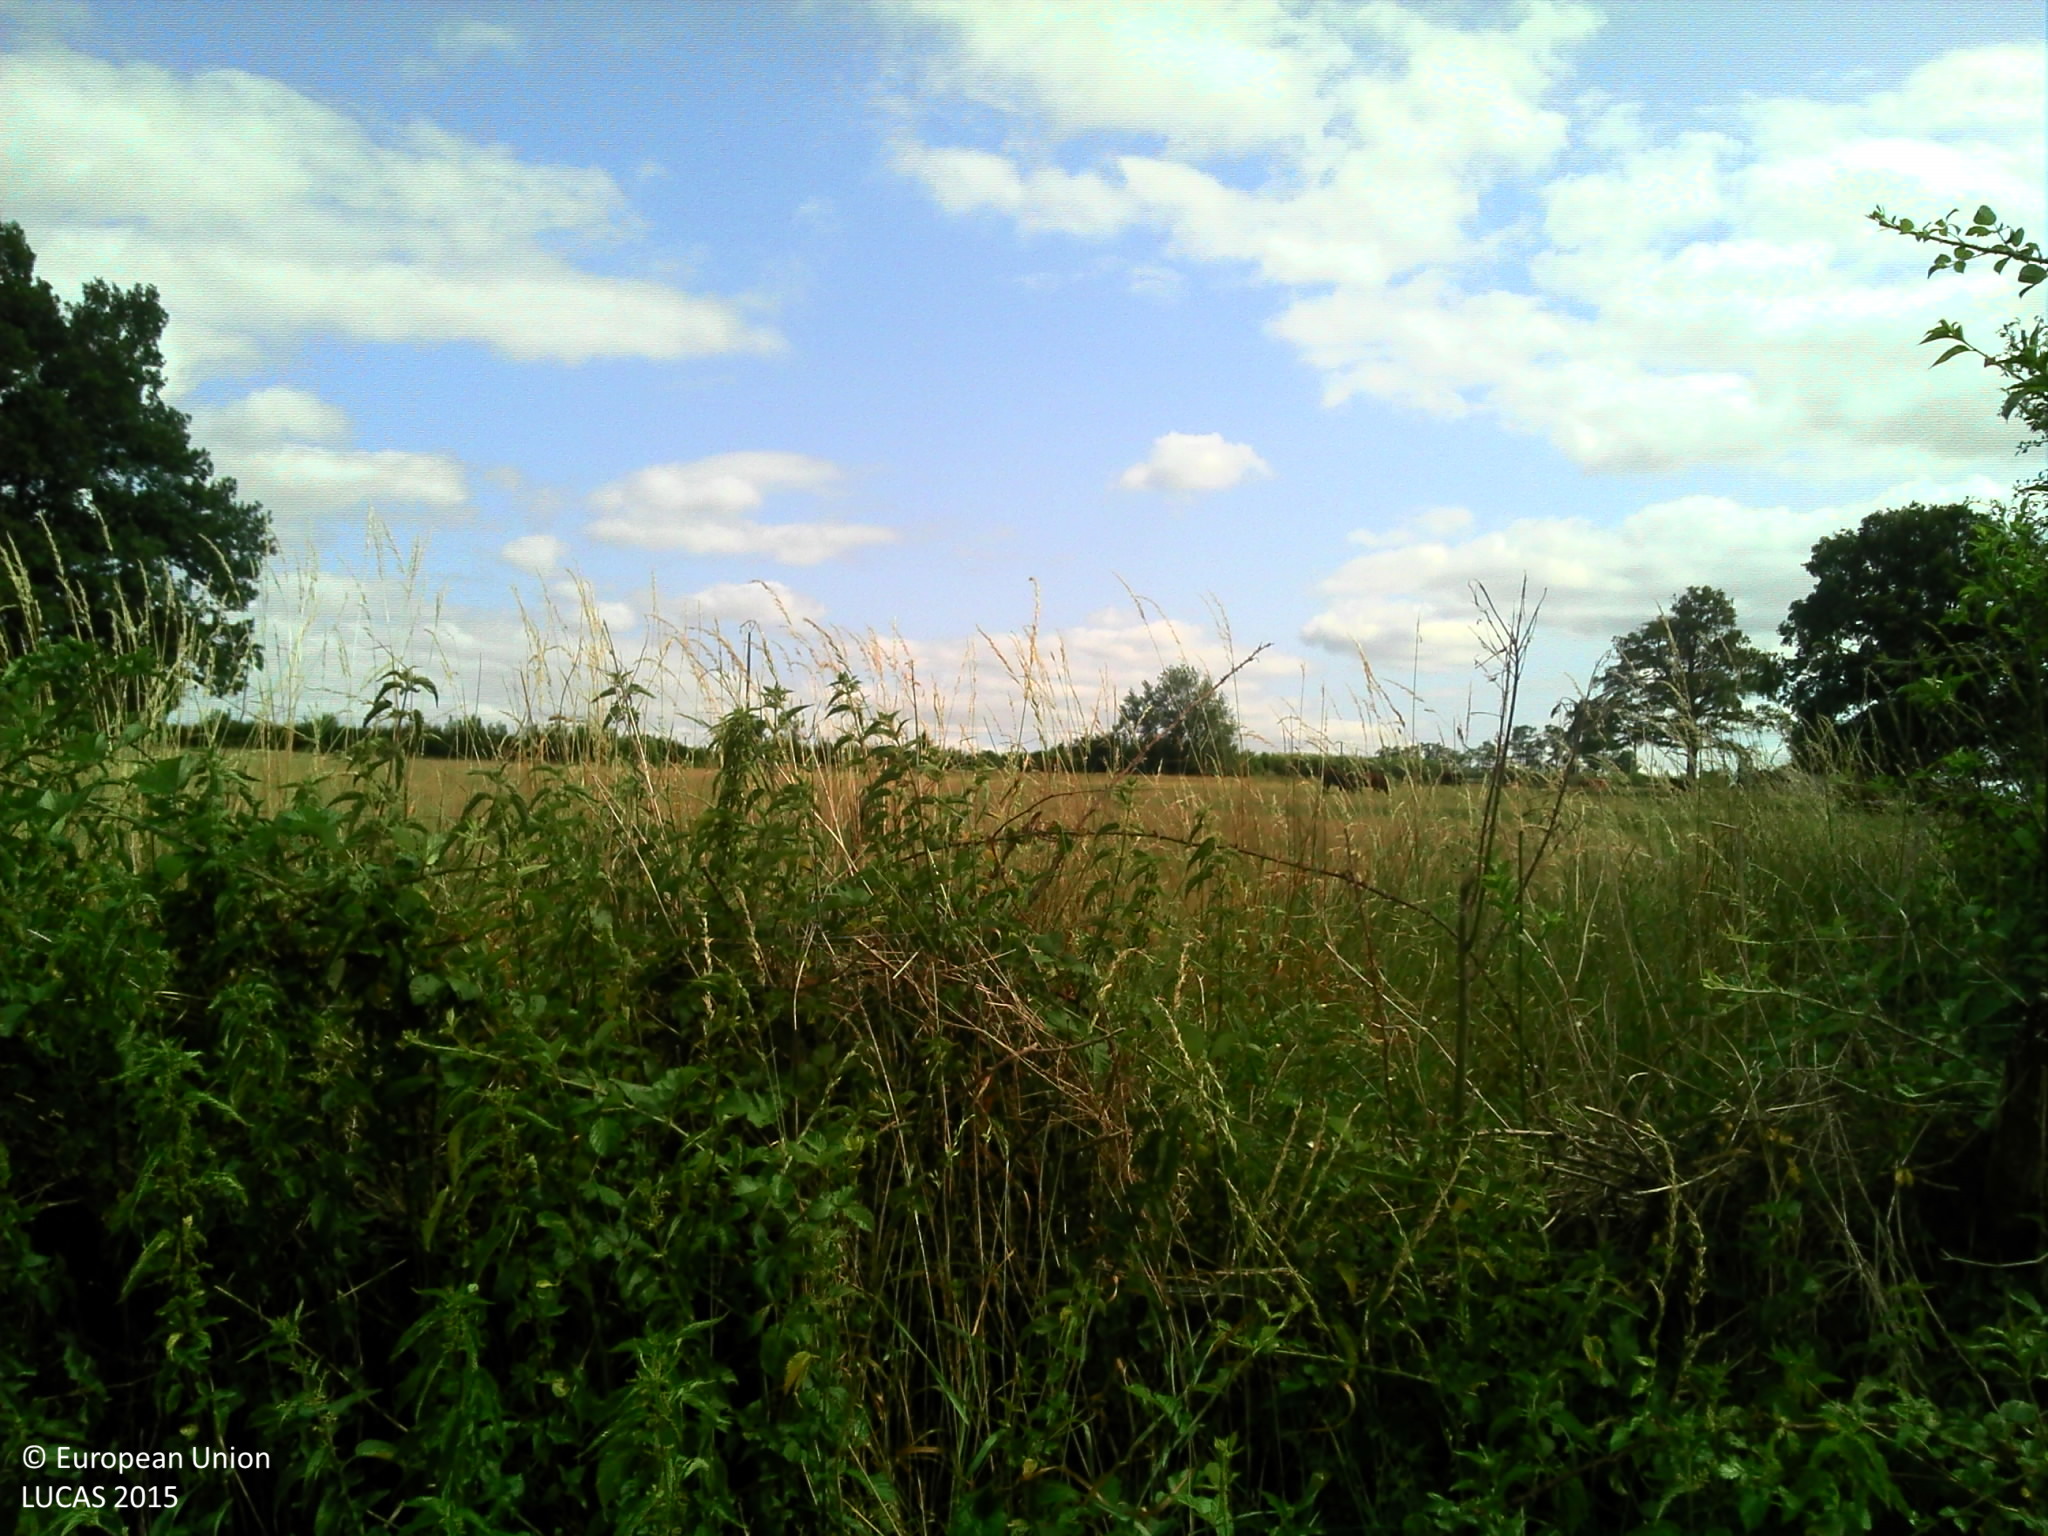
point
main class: Grassland
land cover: Grassland without tree/shrub cover
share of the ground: > 75 %
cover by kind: herbaceous plants 100 %
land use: Agriculture (excluding fallow land and kitchen gardens)
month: July
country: FR
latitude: 46.4492
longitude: 3.0327
